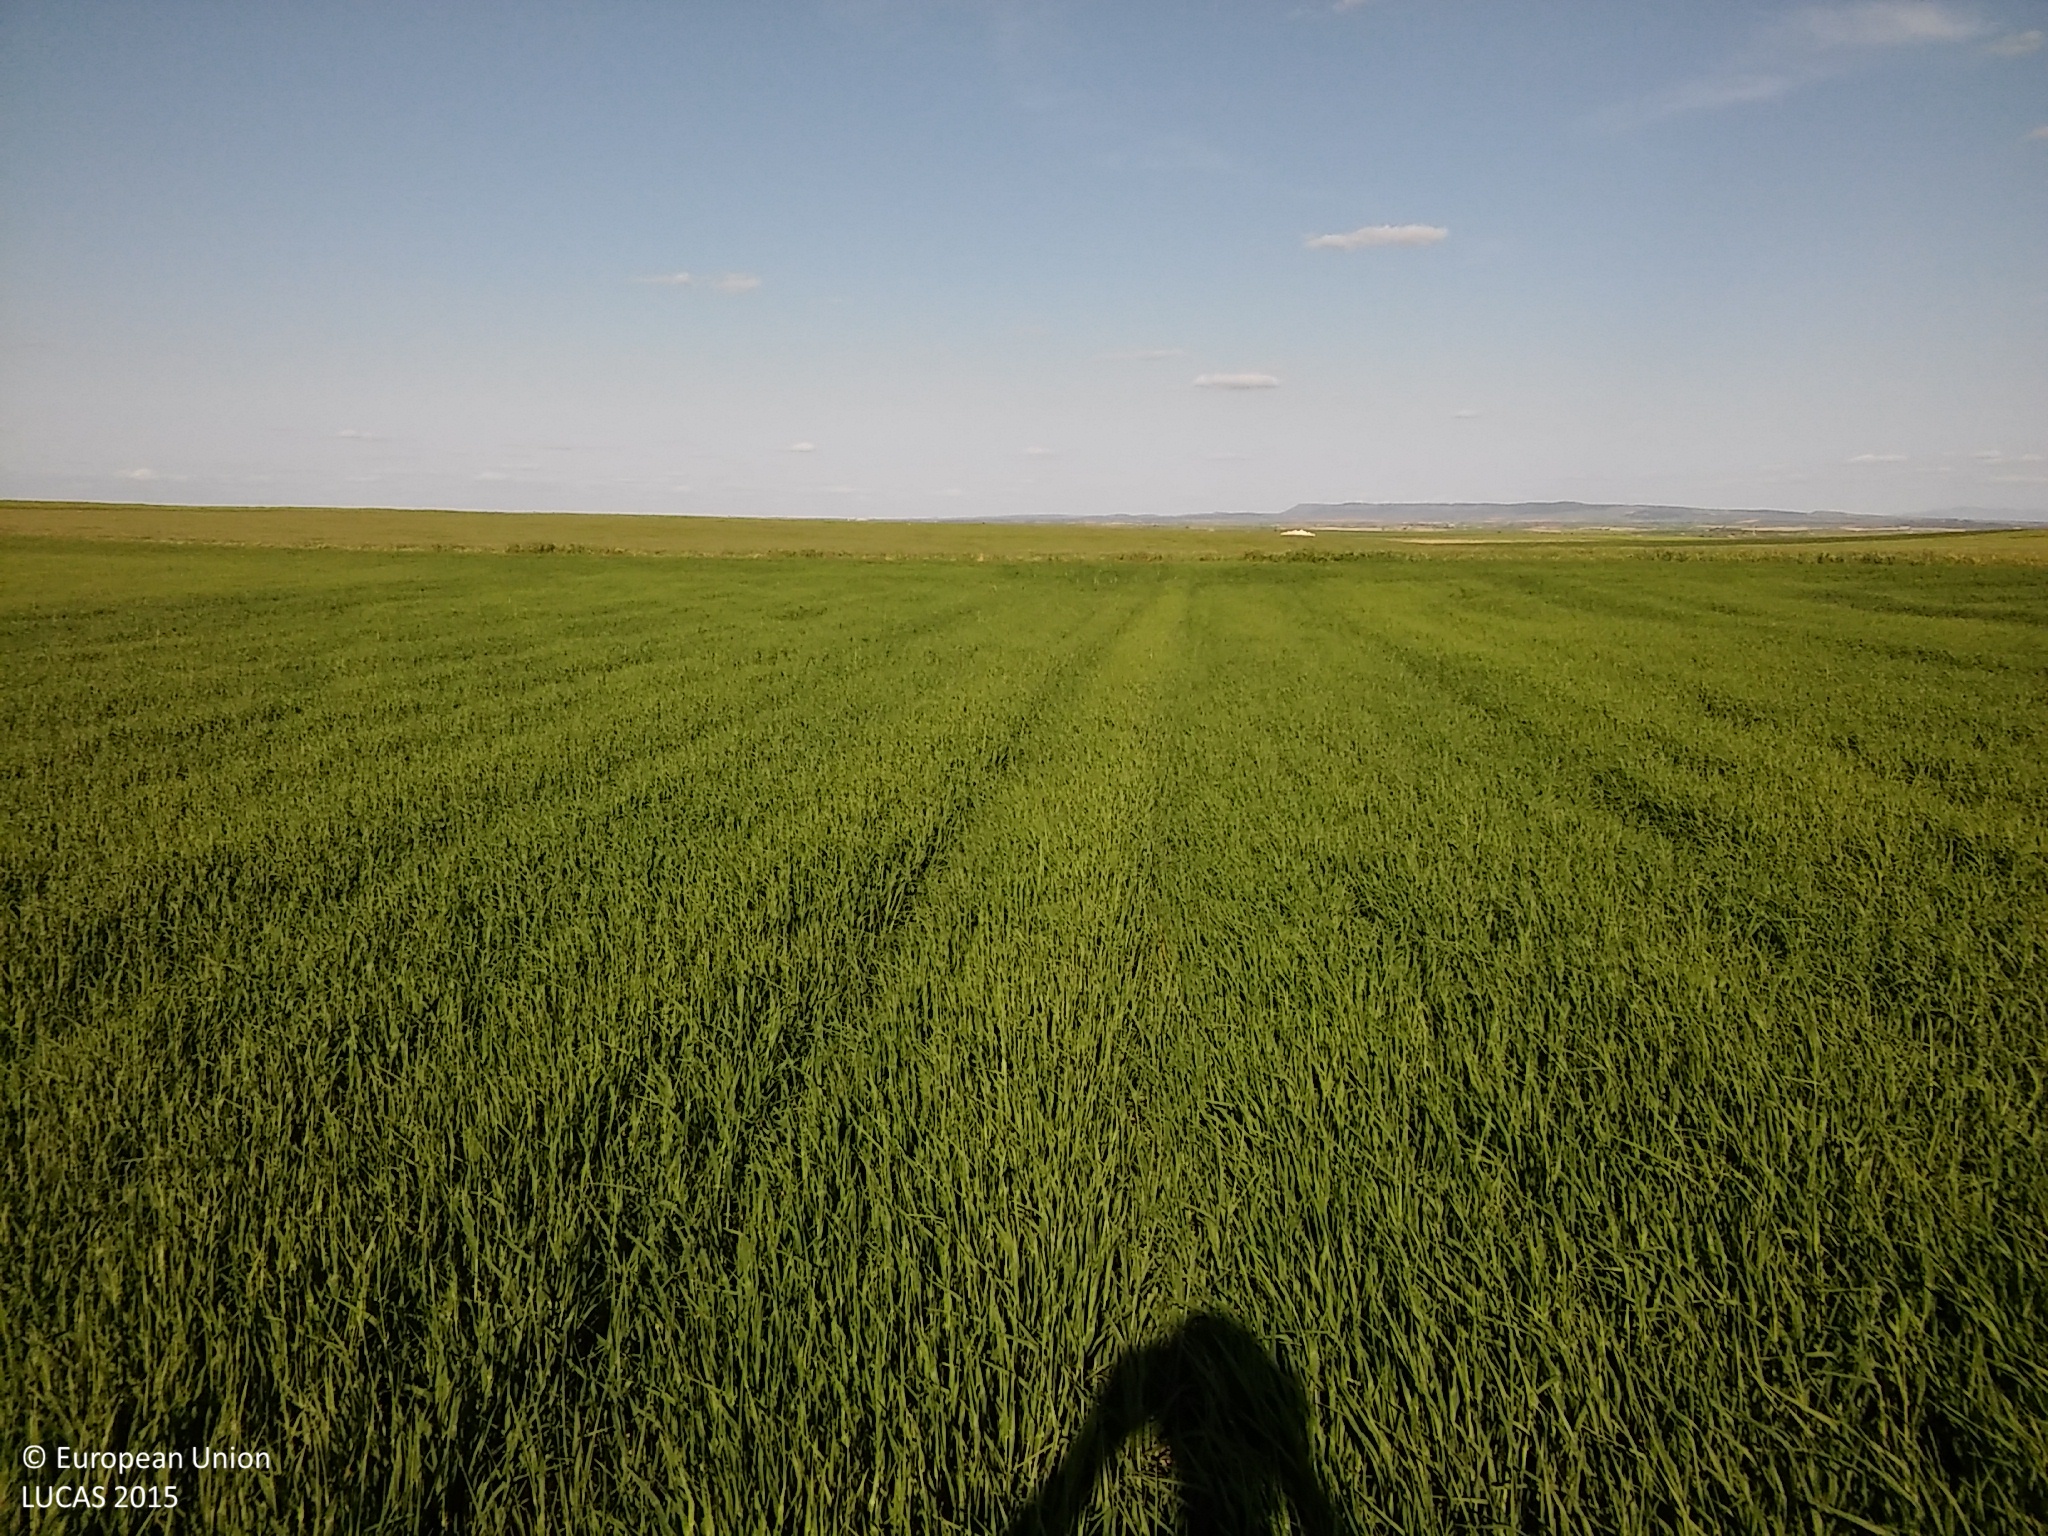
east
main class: Cropland
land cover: Barley
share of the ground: > 75 %
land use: Agriculture (excluding fallow land and kitchen gardens)
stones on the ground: 25 - 50 %
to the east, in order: Barley; Spontaneously vegetated surfaces; Barley
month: May
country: ES
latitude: 41.4784
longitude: -4.1040
